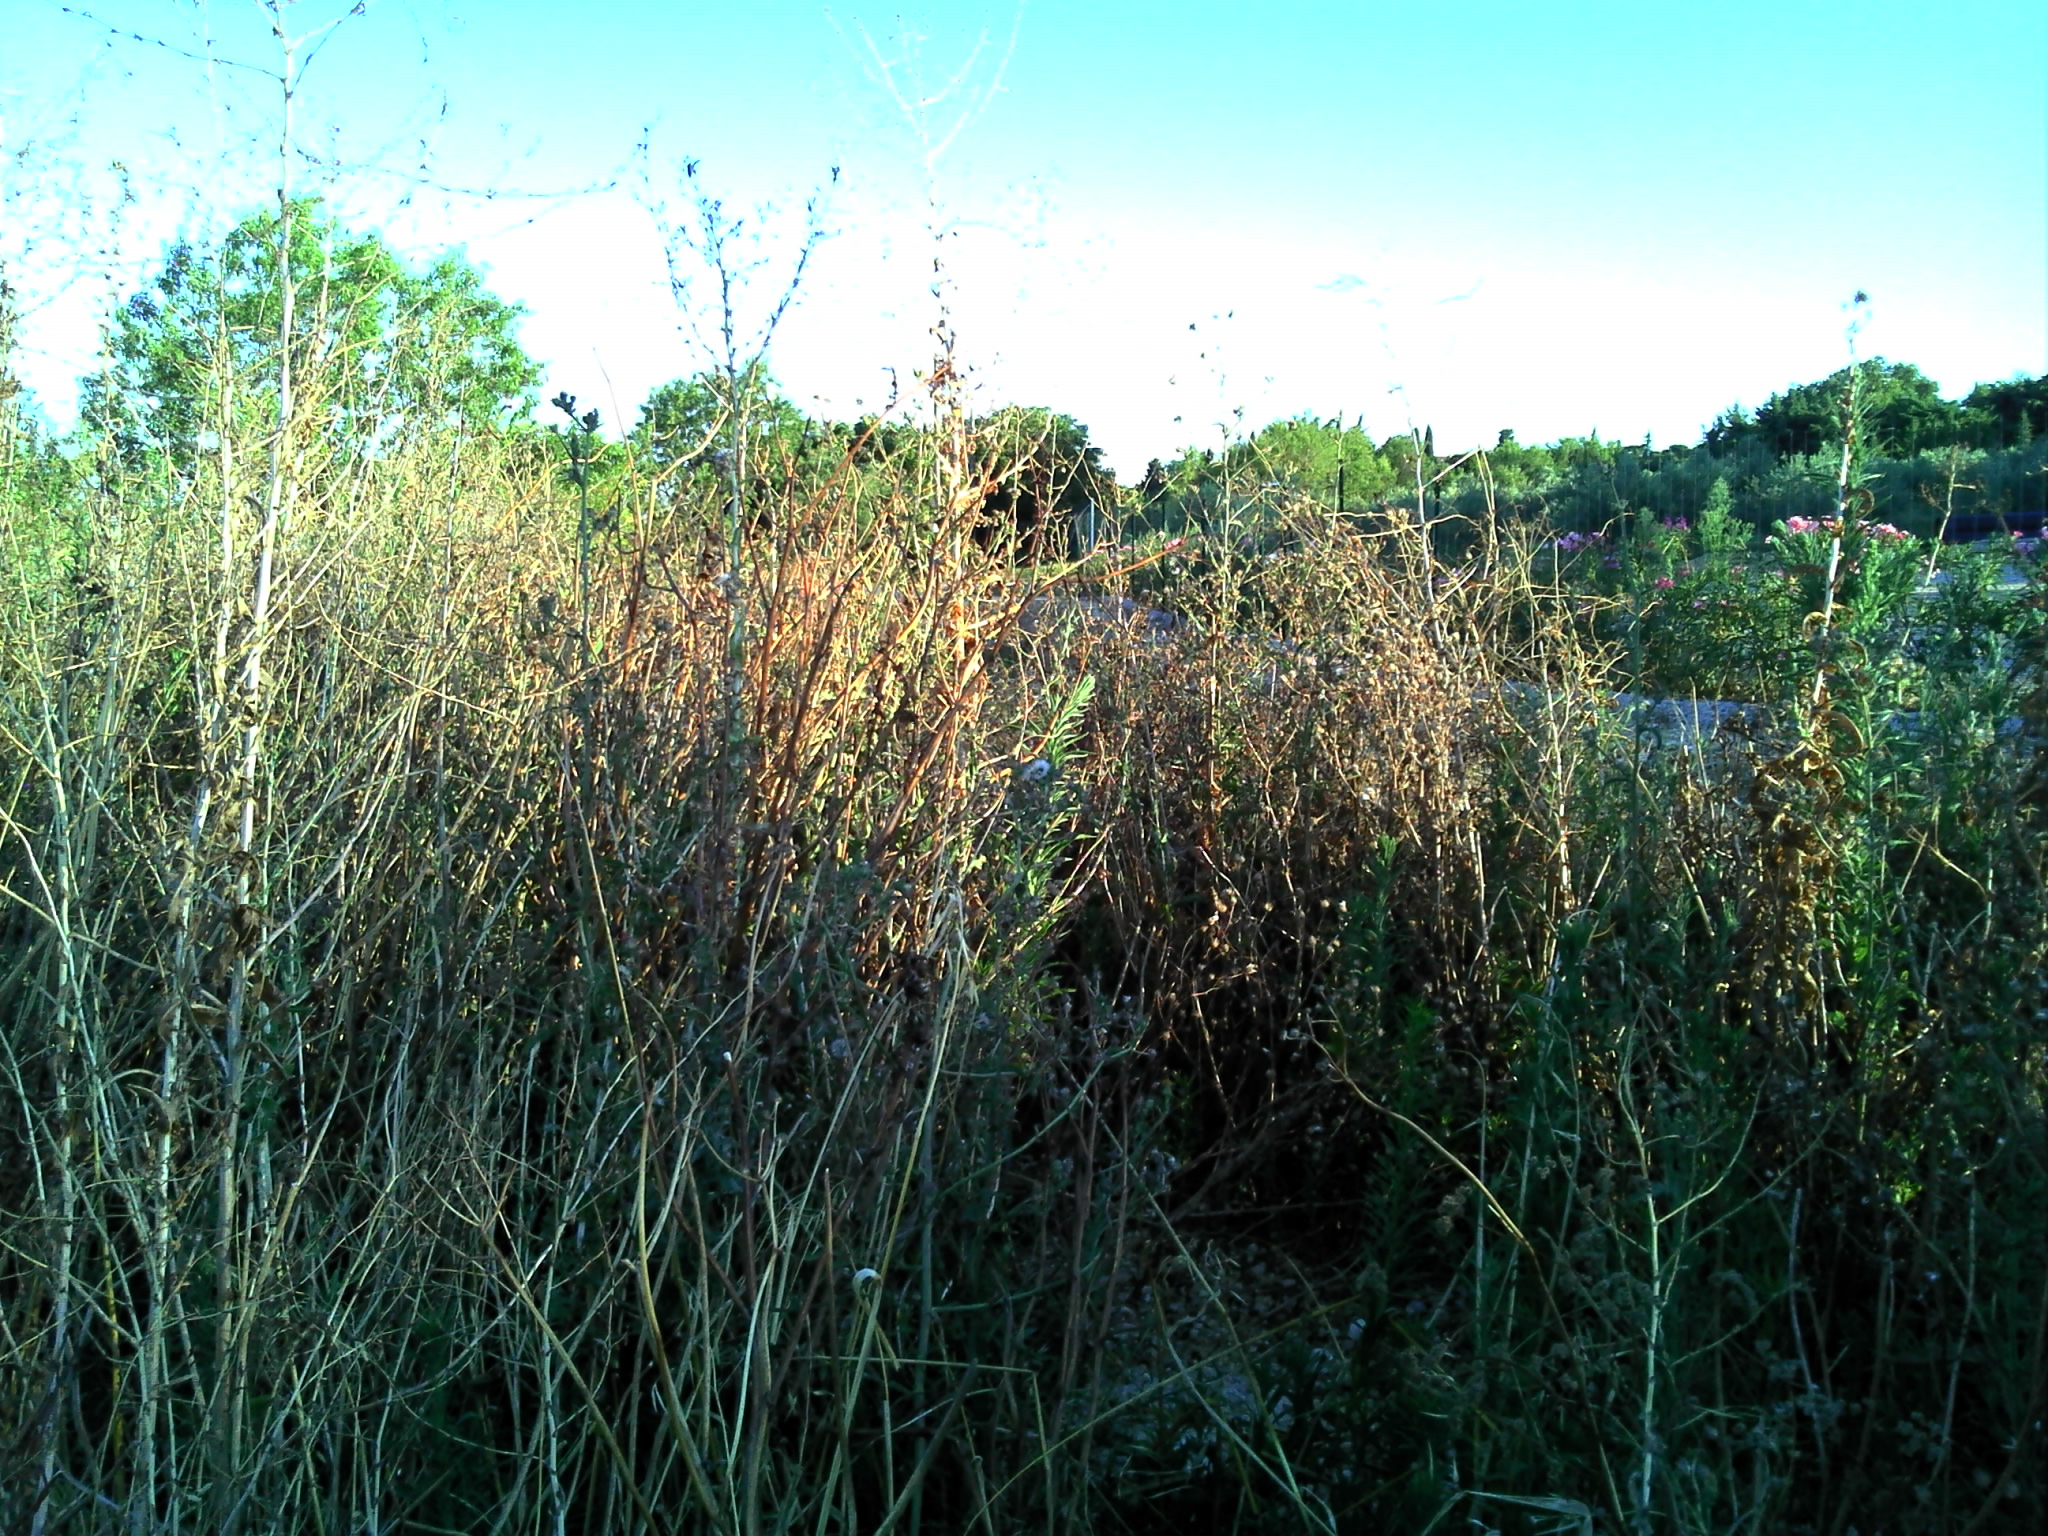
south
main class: Grassland
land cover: Spontaneously vegetated surfaces
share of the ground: > 75 %
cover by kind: herbaceous plants 90 %, shrubs 5 %, consolidated bare surface 5 %
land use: Abandoned areas
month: August
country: FR
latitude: 43.9409
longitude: 4.6389
